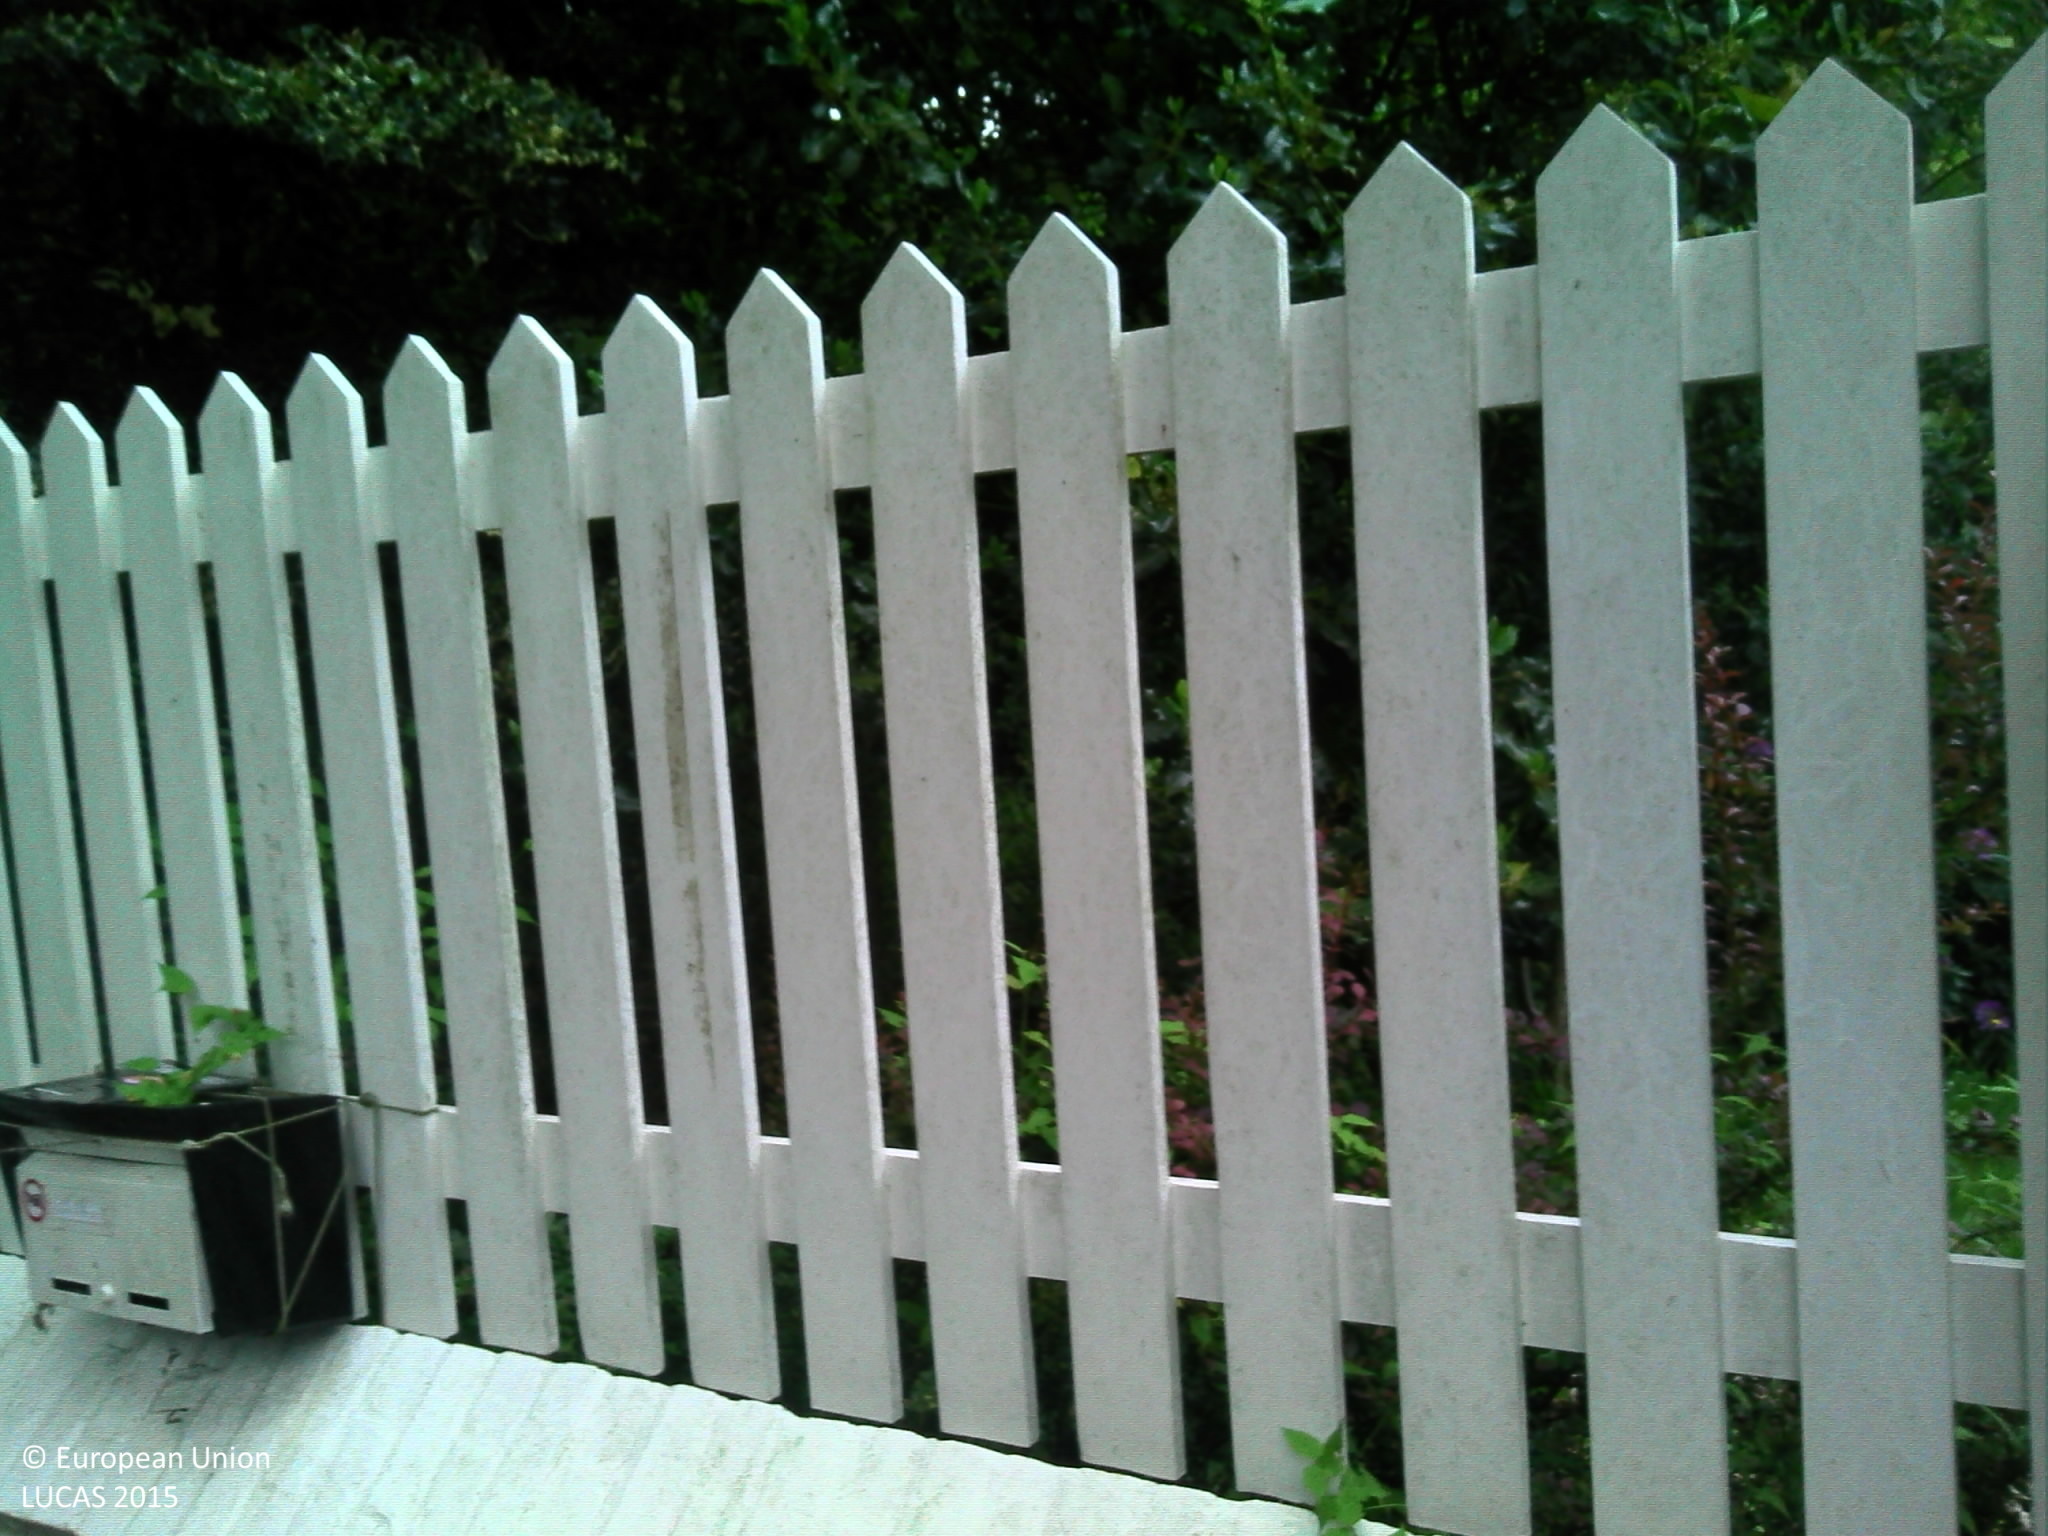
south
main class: Grassland
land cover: Grassland with sparse tree/shrub cover
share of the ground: > 75 %
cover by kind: herbaceous plants 95 %, broadleaved forest trees 5 %
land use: Residential
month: May
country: BE
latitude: 50.6872
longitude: 4.6032
